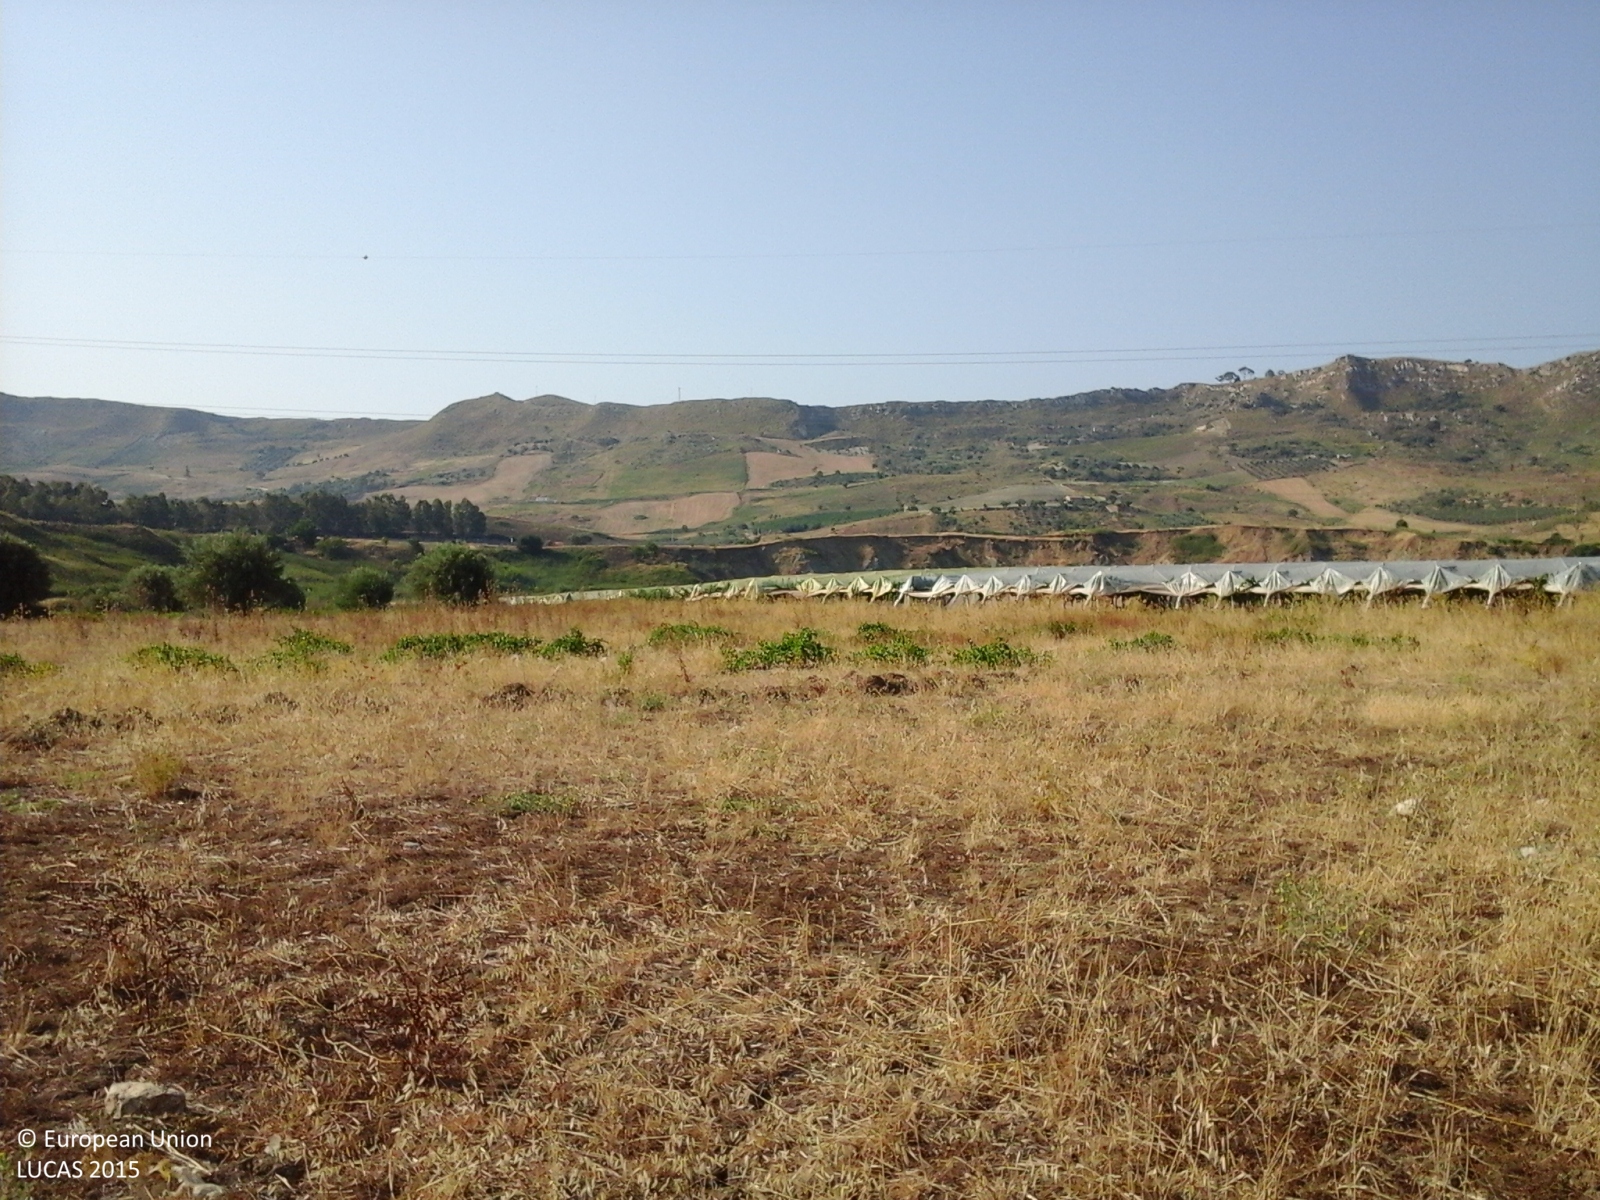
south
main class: Grassland
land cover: Spontaneously vegetated surfaces
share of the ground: > 75 %
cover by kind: herbaceous plants 100 %
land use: Agriculture (excluding fallow land and kitchen gardens)
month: July
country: IT
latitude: 37.1749
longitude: 13.9448
